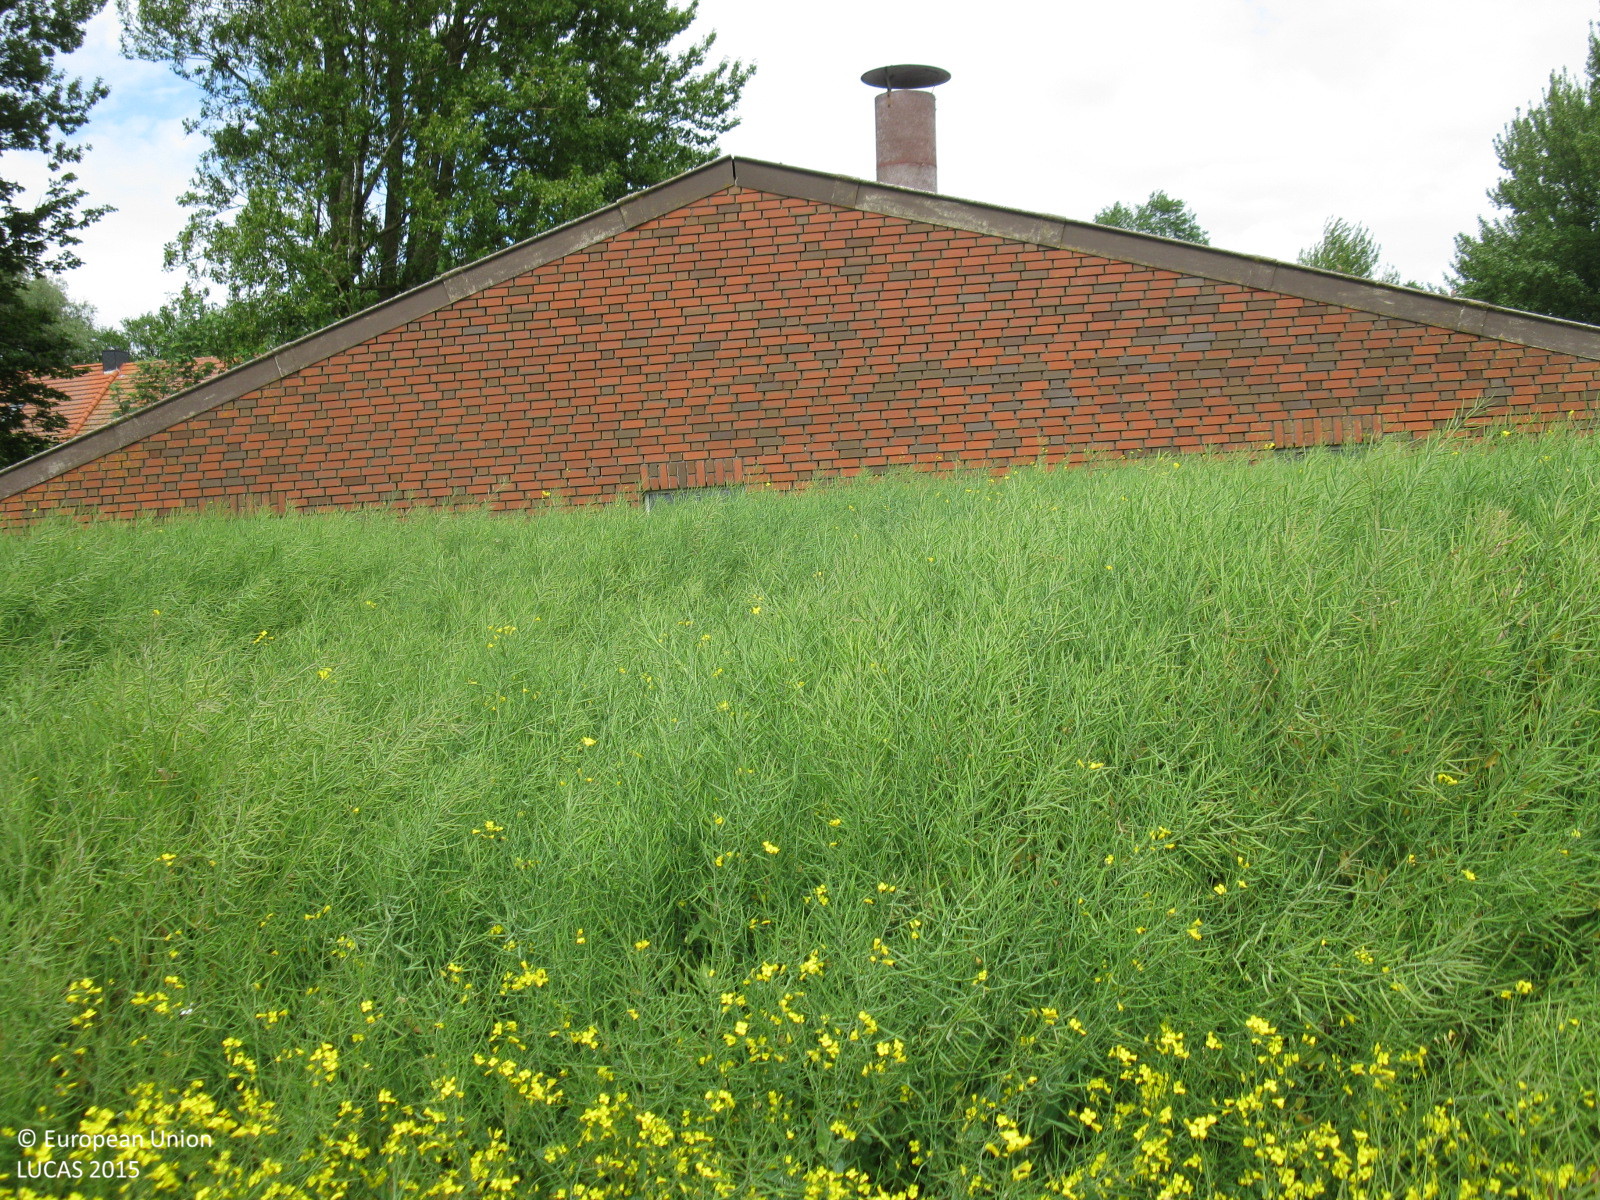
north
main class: Cropland
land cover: Rape and turnip rape
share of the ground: > 75 %
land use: Agriculture (excluding fallow land and kitchen gardens)
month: June
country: DE
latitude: 53.7088
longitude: 7.9858
